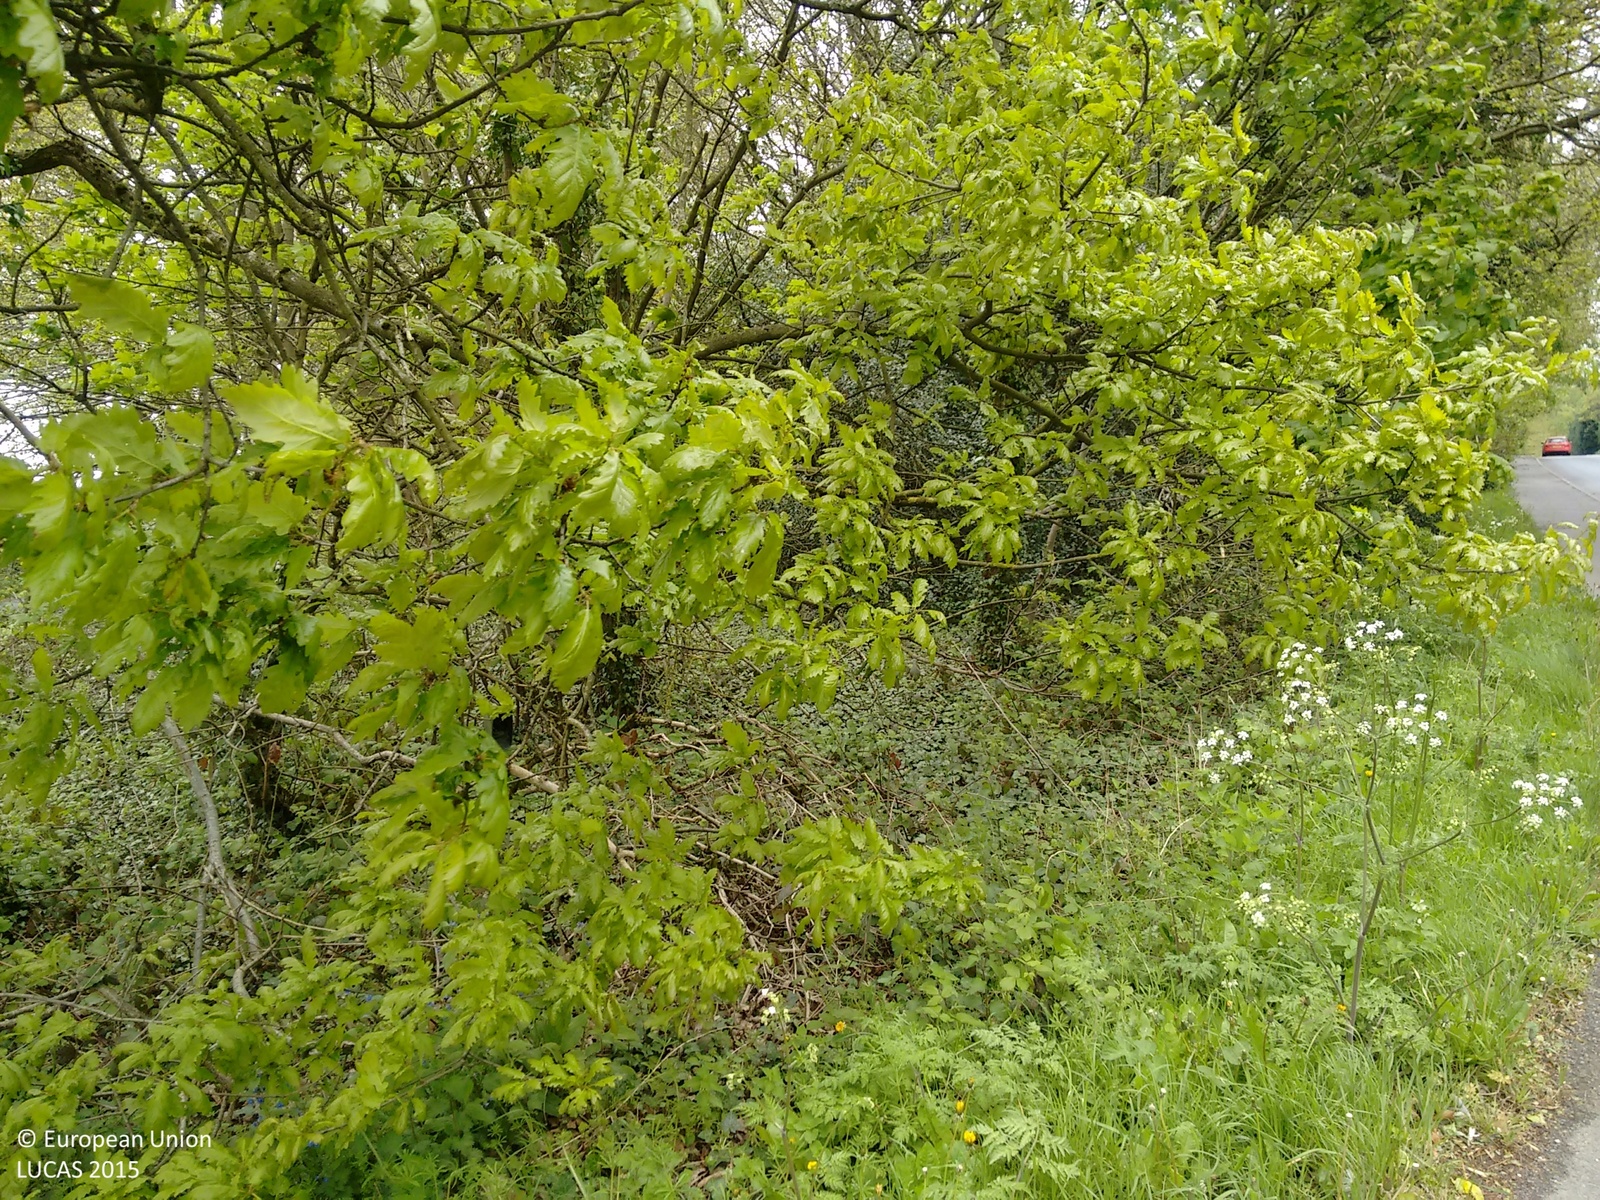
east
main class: Woodland
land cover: Broadleaved woodland
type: mesophytic deciduous forest
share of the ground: > 75 %
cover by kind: broadleaved forest trees 80 %, shrubs 20 %
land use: Forestry
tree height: > 5 m
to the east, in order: Broadleaved woodland; Grass margins; Paved roads, cycling and walking lanes; Broadleaved woodland
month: May
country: GB
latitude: 51.2856
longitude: 0.2339
